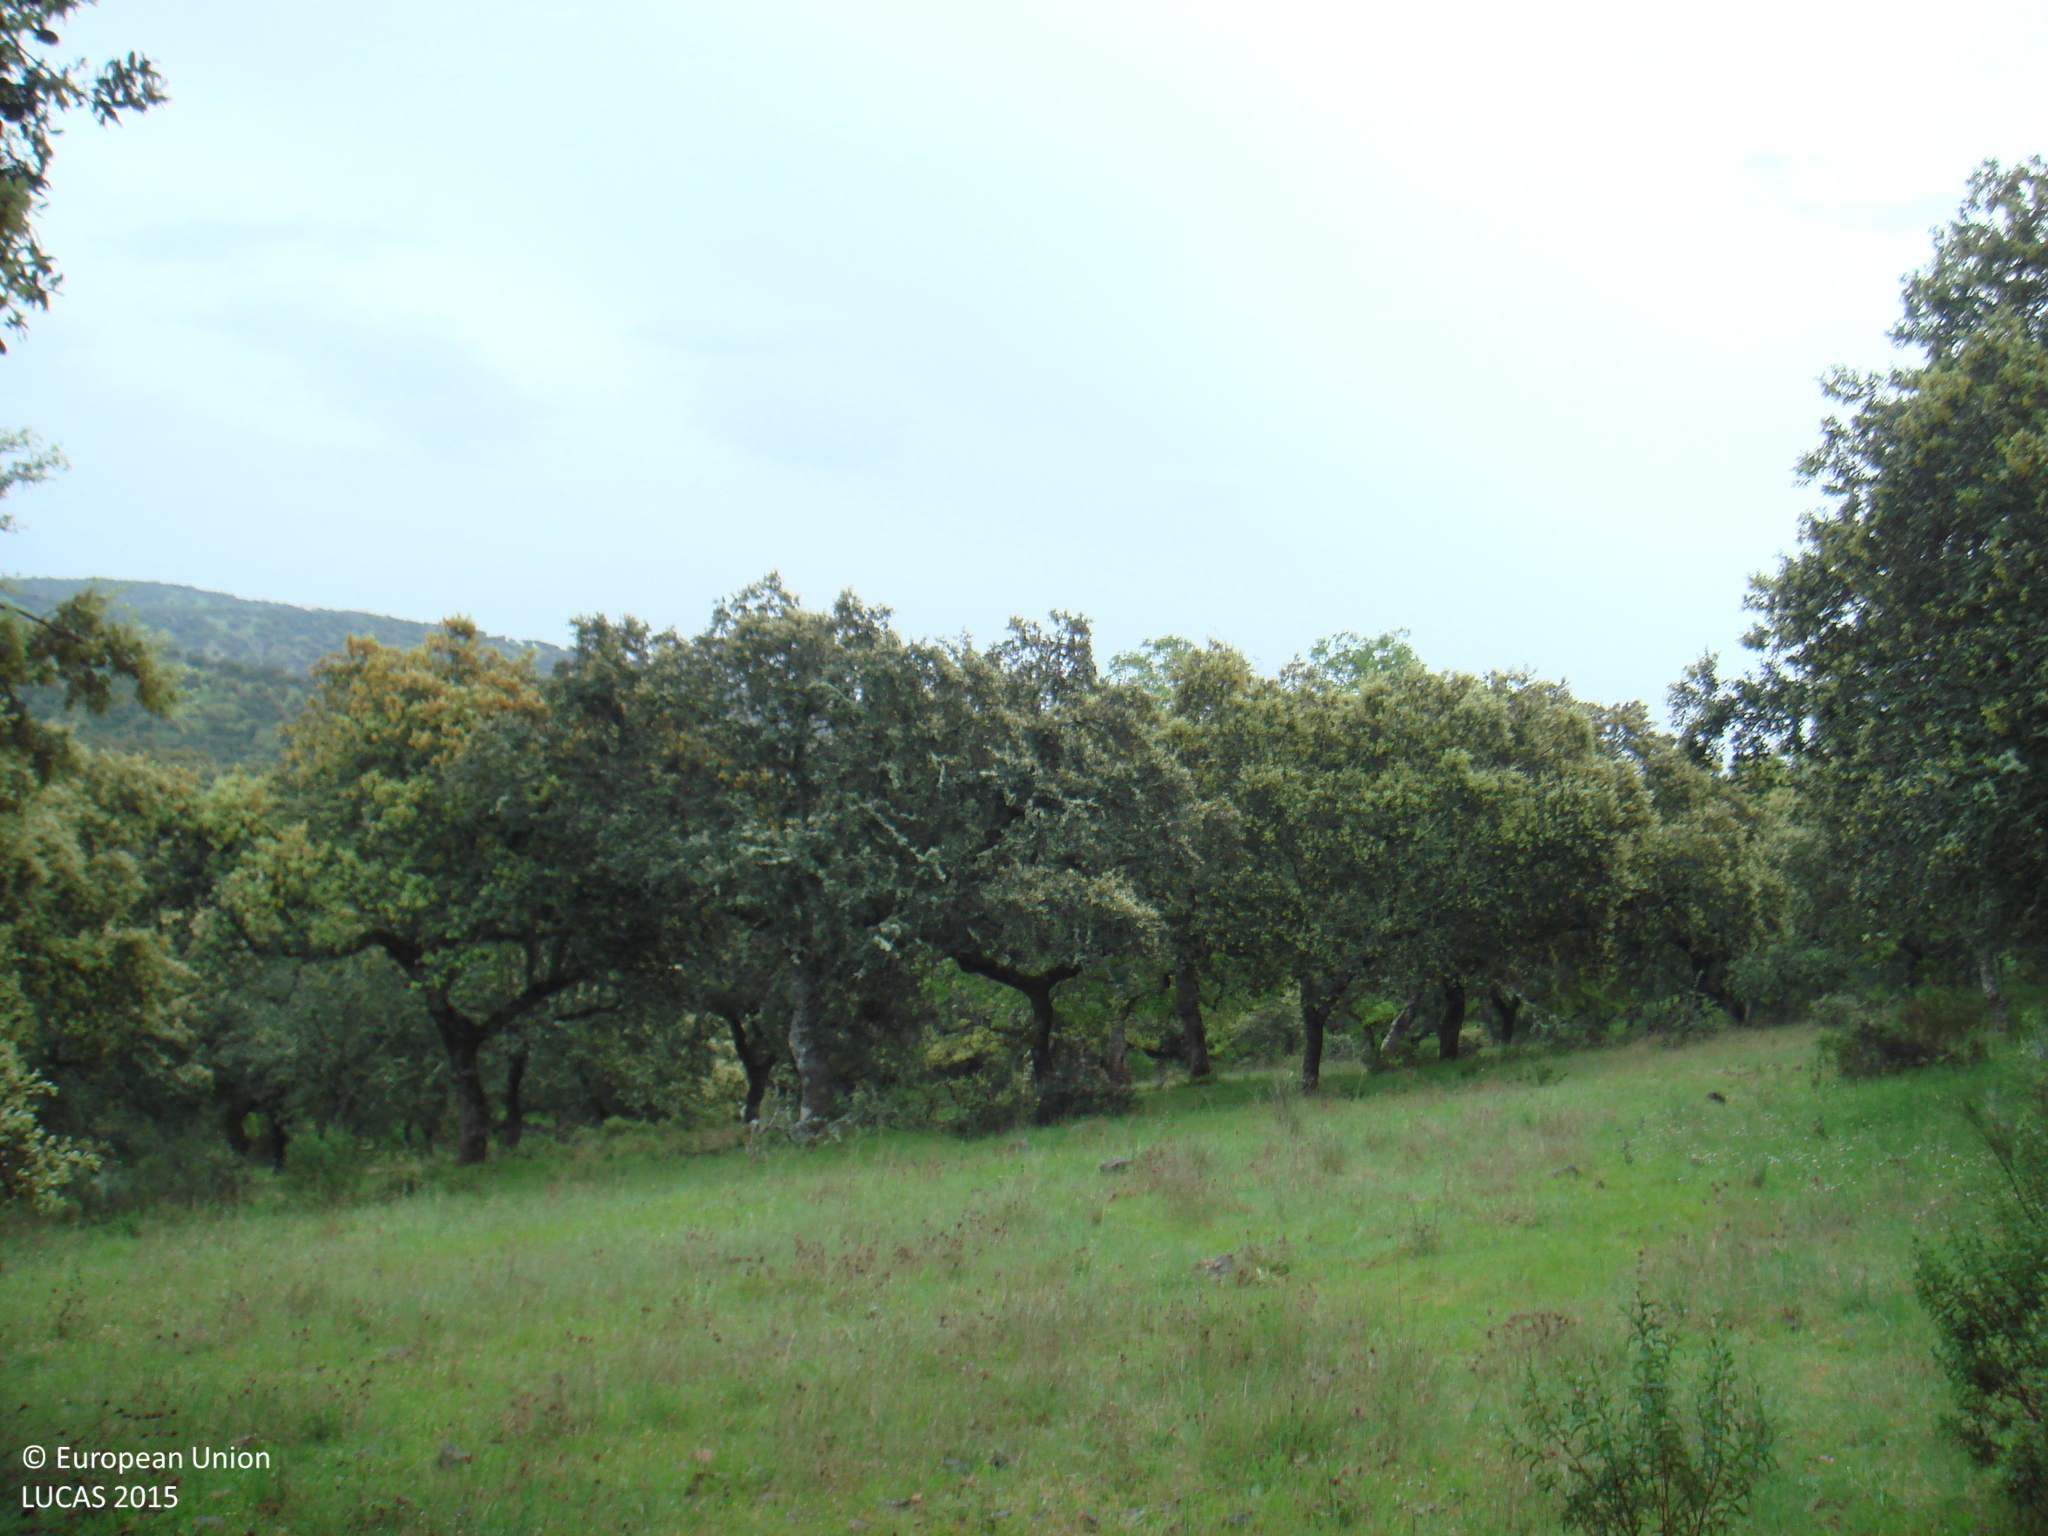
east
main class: Woodland
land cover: Broadleaved woodland
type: broadleaved evergreen forest
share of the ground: 50 - 75 %
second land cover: Spontaneously vegetated surfaces
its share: 50 - 75 %
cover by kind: broadleaved forest trees 60 %, herbaceous plants 30 %, shrubs 10 %
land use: Forestry
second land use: Agriculture (excluding fallow land and kitchen gardens)
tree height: > 5 m
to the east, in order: Broadleaved woodland; Spontaneously vegetated surfaces; Rivers and streams; Broadleaved woodland
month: April
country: ES
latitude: 38.1925
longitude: -5.3159
